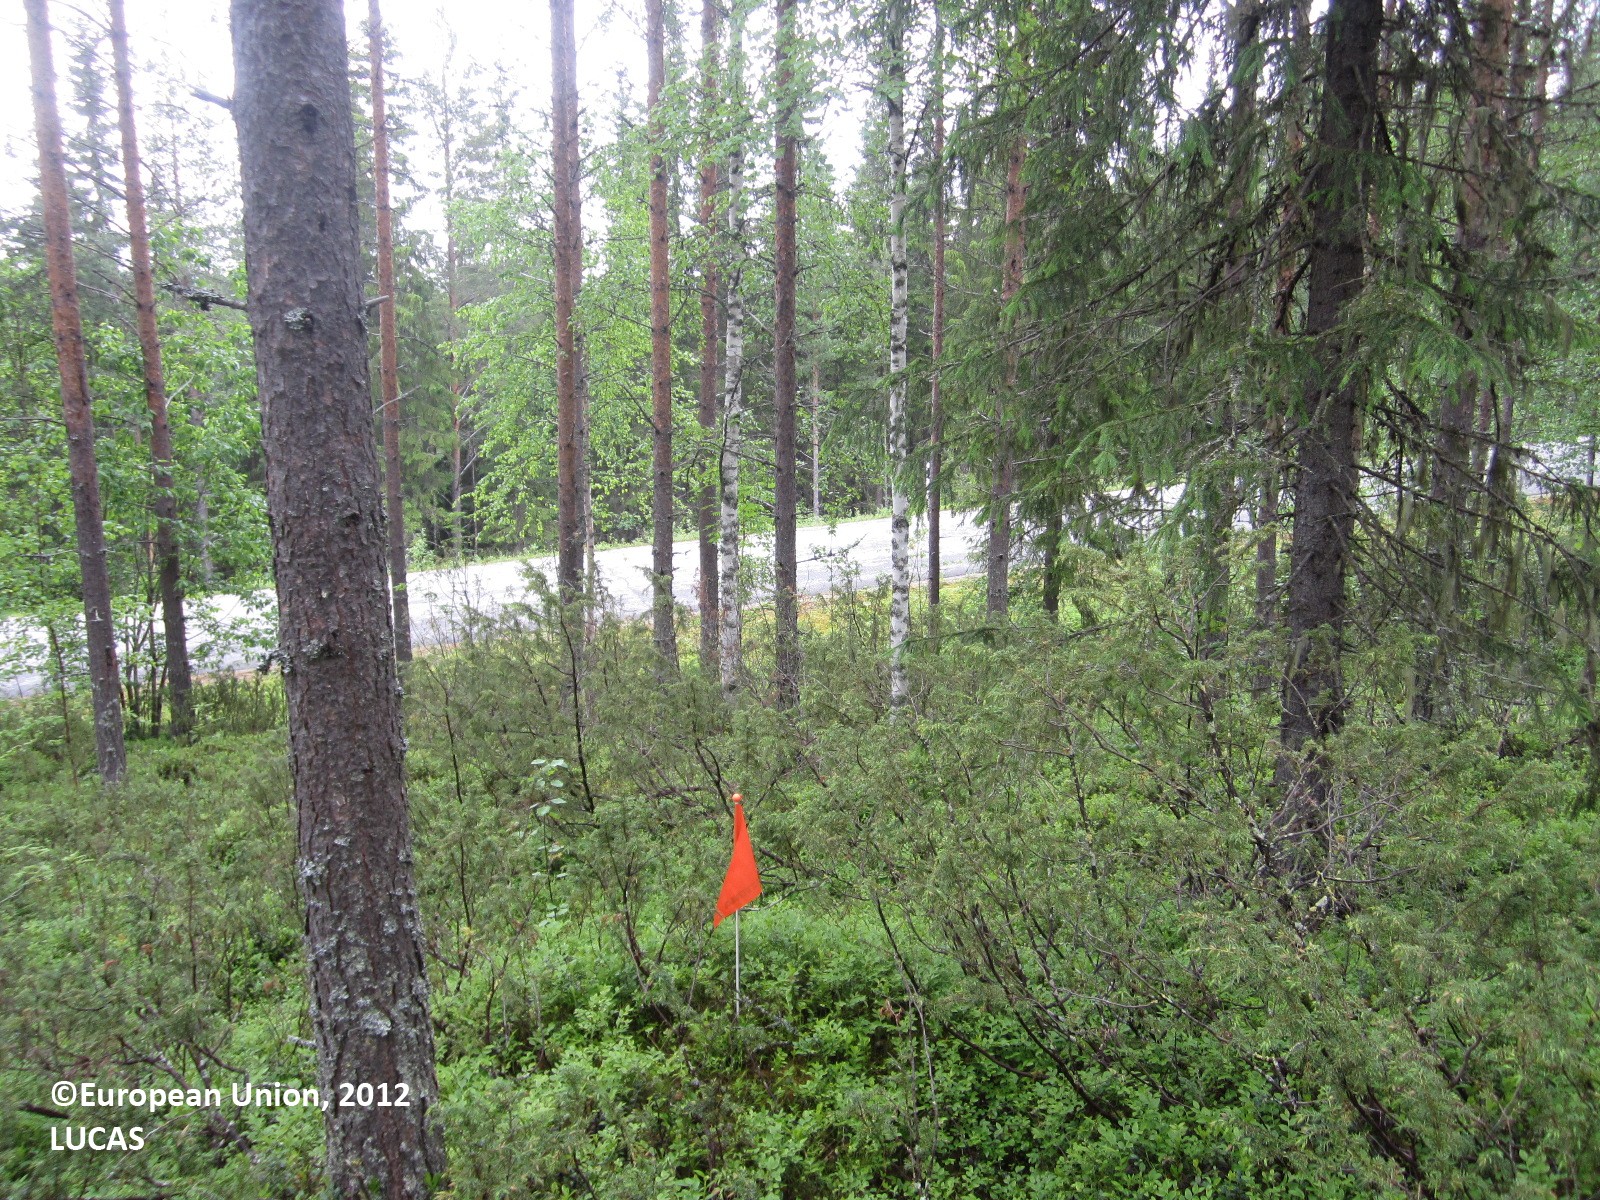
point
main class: Woodland
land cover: Other coniferous woodland
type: boreal forest
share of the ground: > 75 %
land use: Forestry
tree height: > 5 m
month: June
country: FI
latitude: 64.5542
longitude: 29.2044
